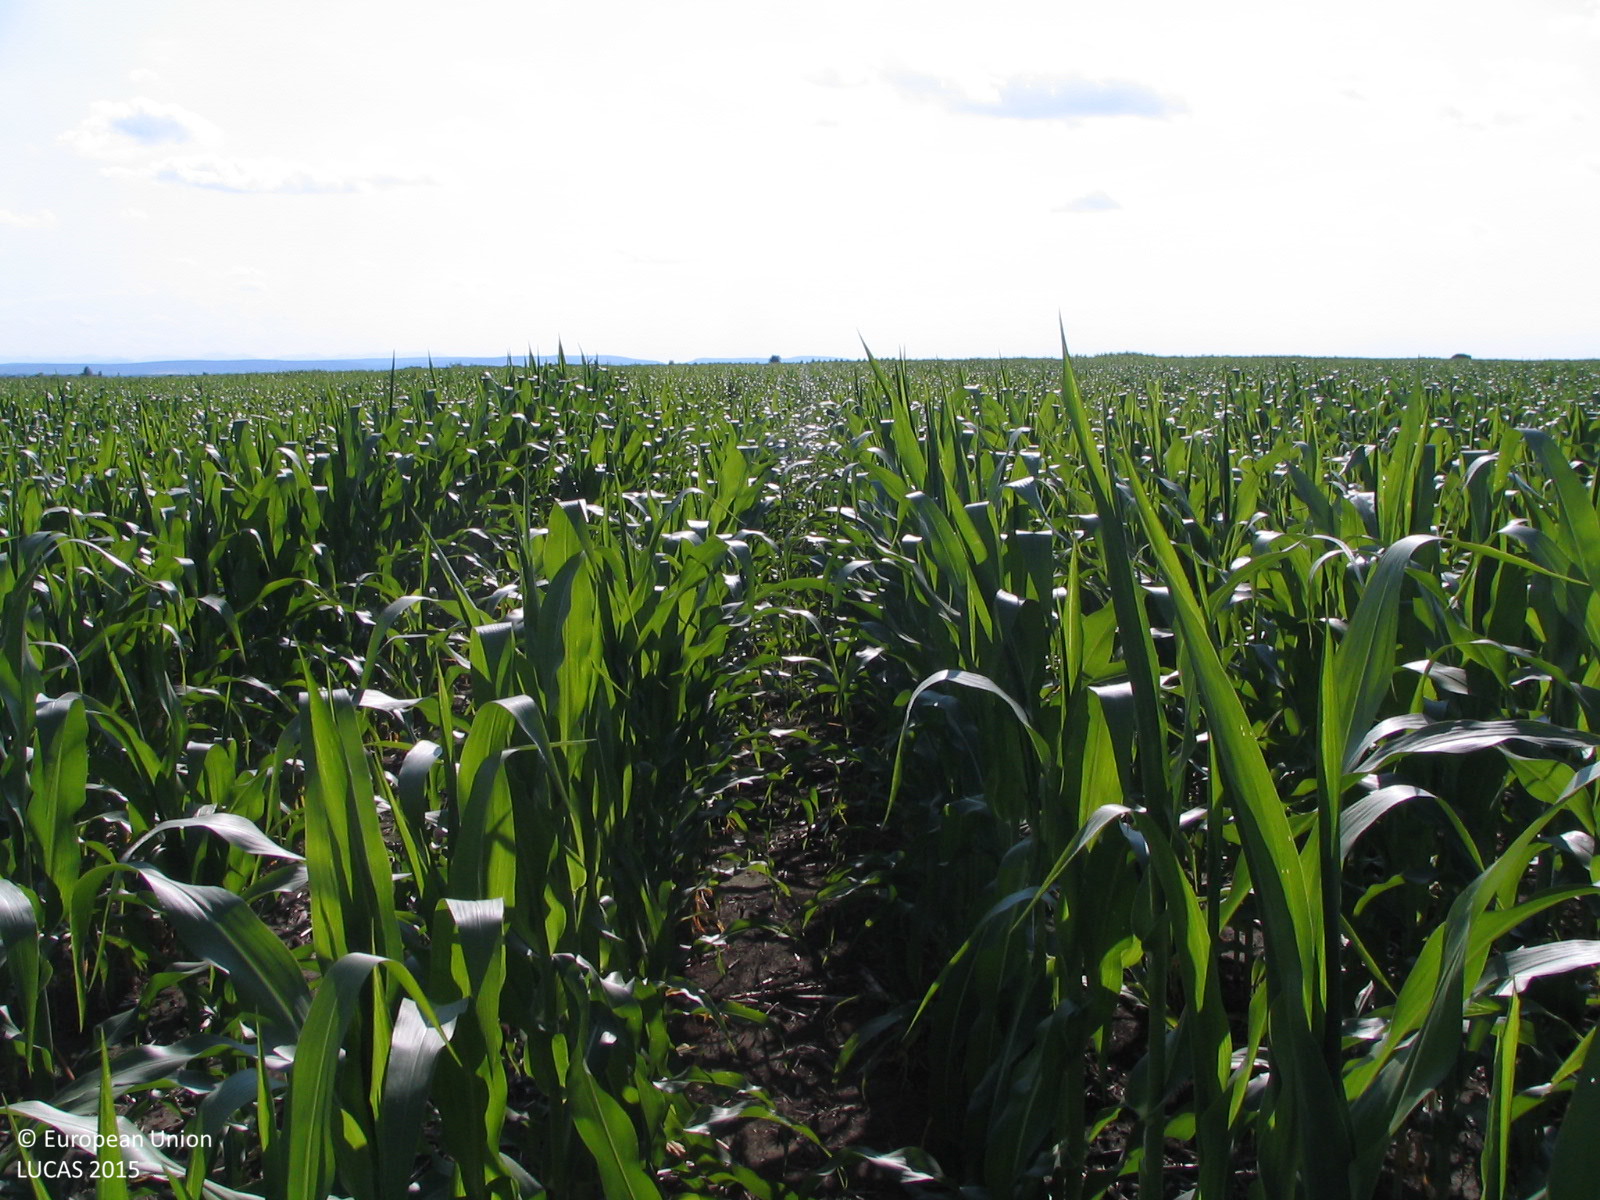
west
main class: Cropland
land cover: Maize
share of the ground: > 75 %
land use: Agriculture (excluding fallow land and kitchen gardens)
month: June
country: BG
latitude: 43.3762
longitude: 24.0109
